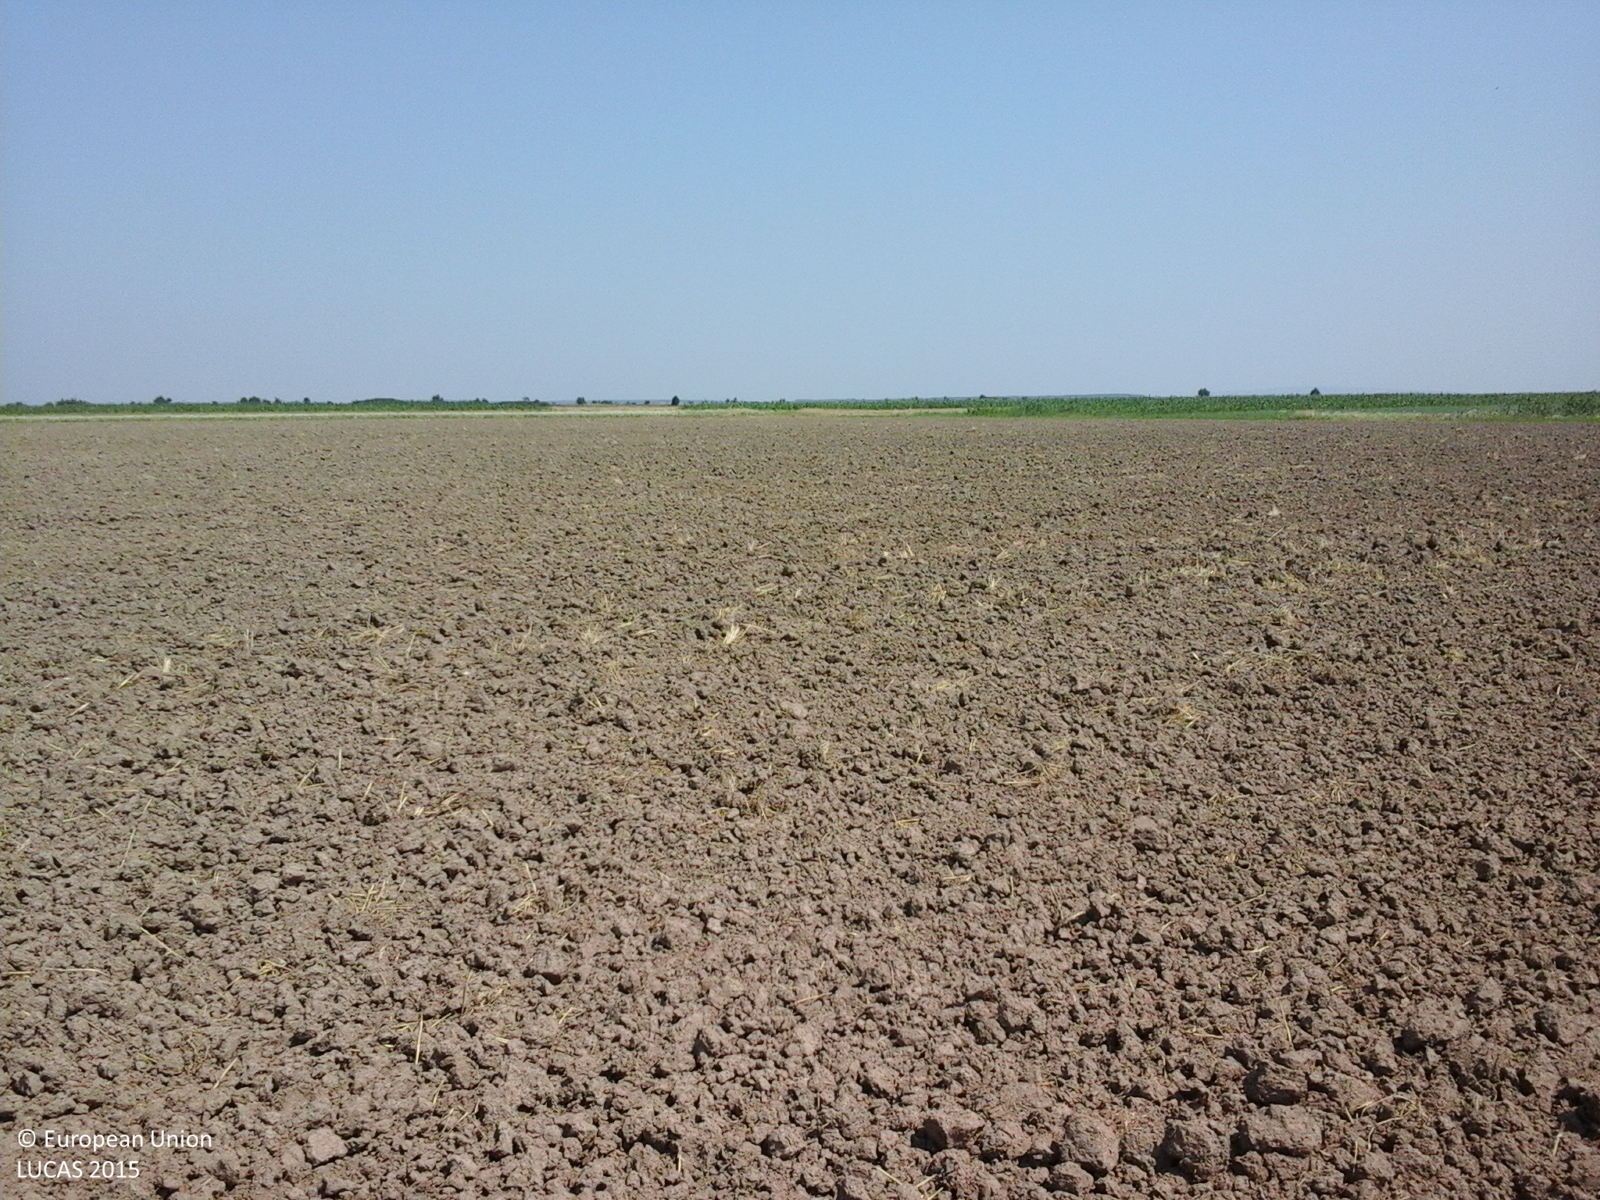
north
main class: Cropland
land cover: Common wheat
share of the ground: < 10 %
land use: Agriculture (excluding fallow land and kitchen gardens)
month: July
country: RO
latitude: 44.7368
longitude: 25.6167
